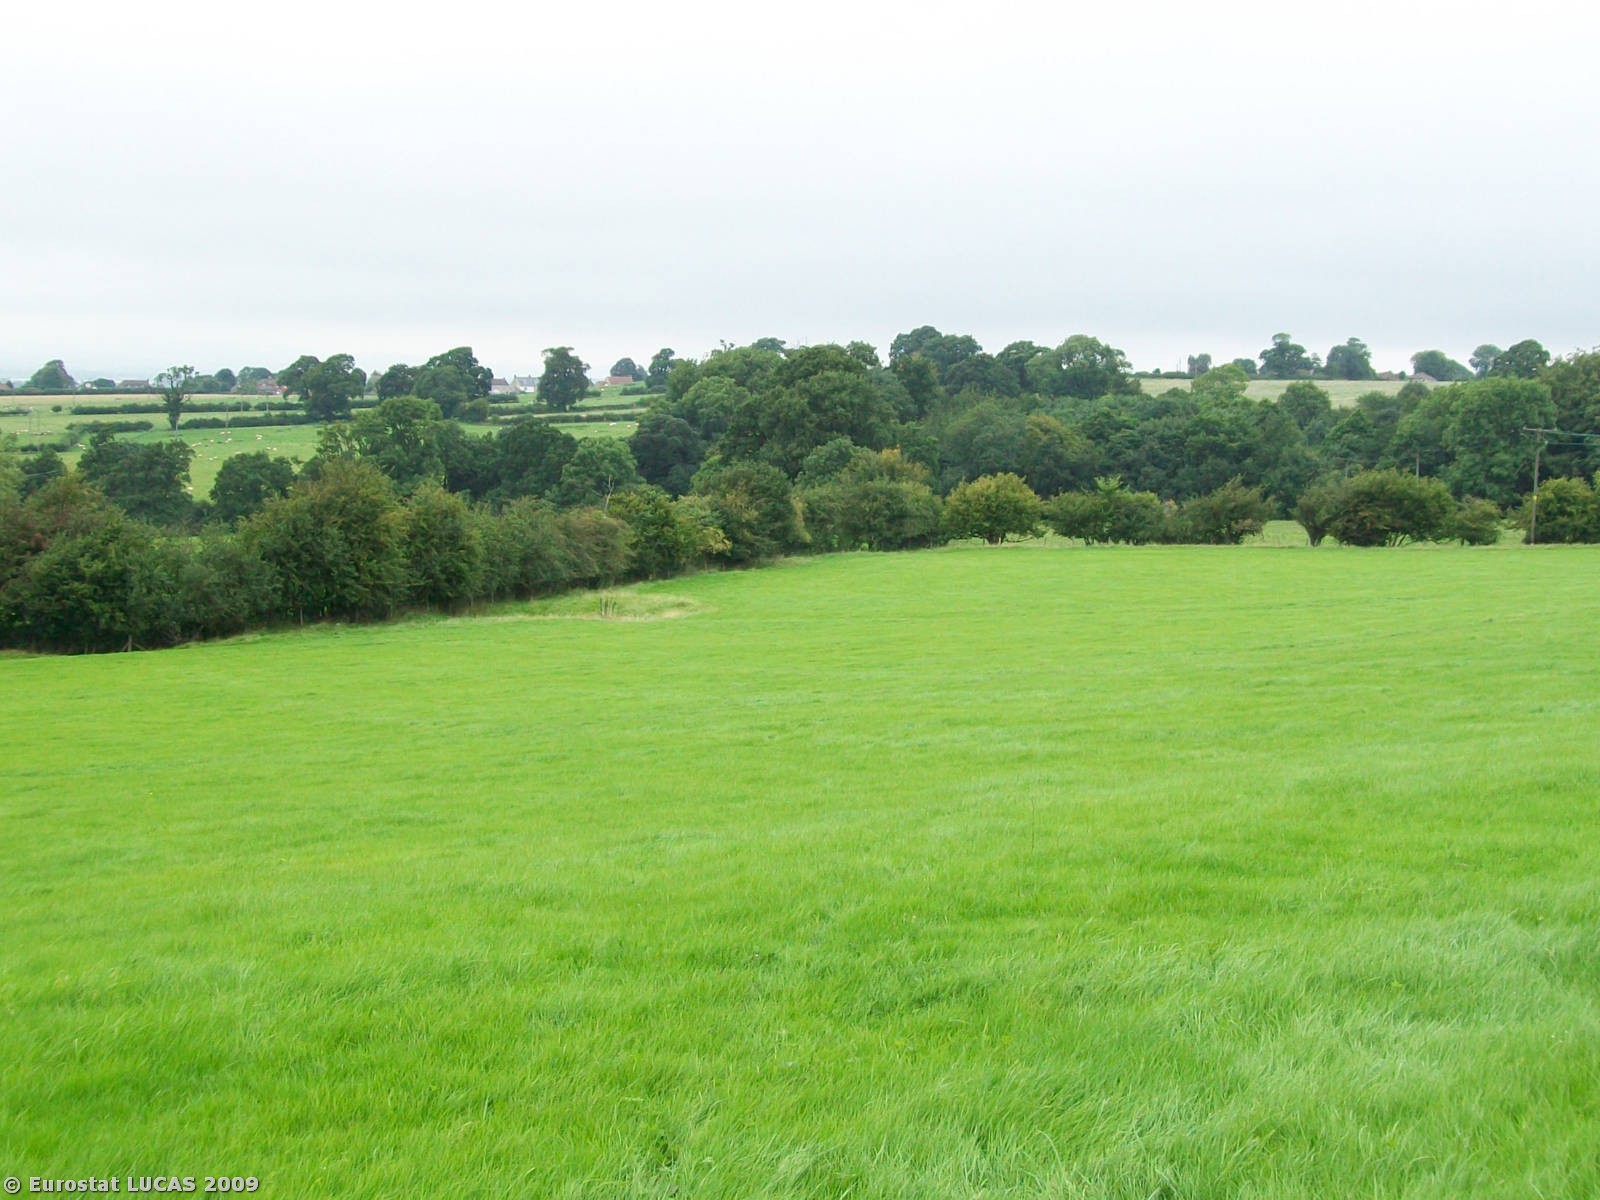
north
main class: Grassland
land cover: Grassland without tree/shrub cover
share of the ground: > 75 %
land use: Agriculture (excluding fallow land and kitchen gardens)
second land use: Community services
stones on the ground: < 10 %
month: August
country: GB
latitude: 51.6935
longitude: -2.3464
